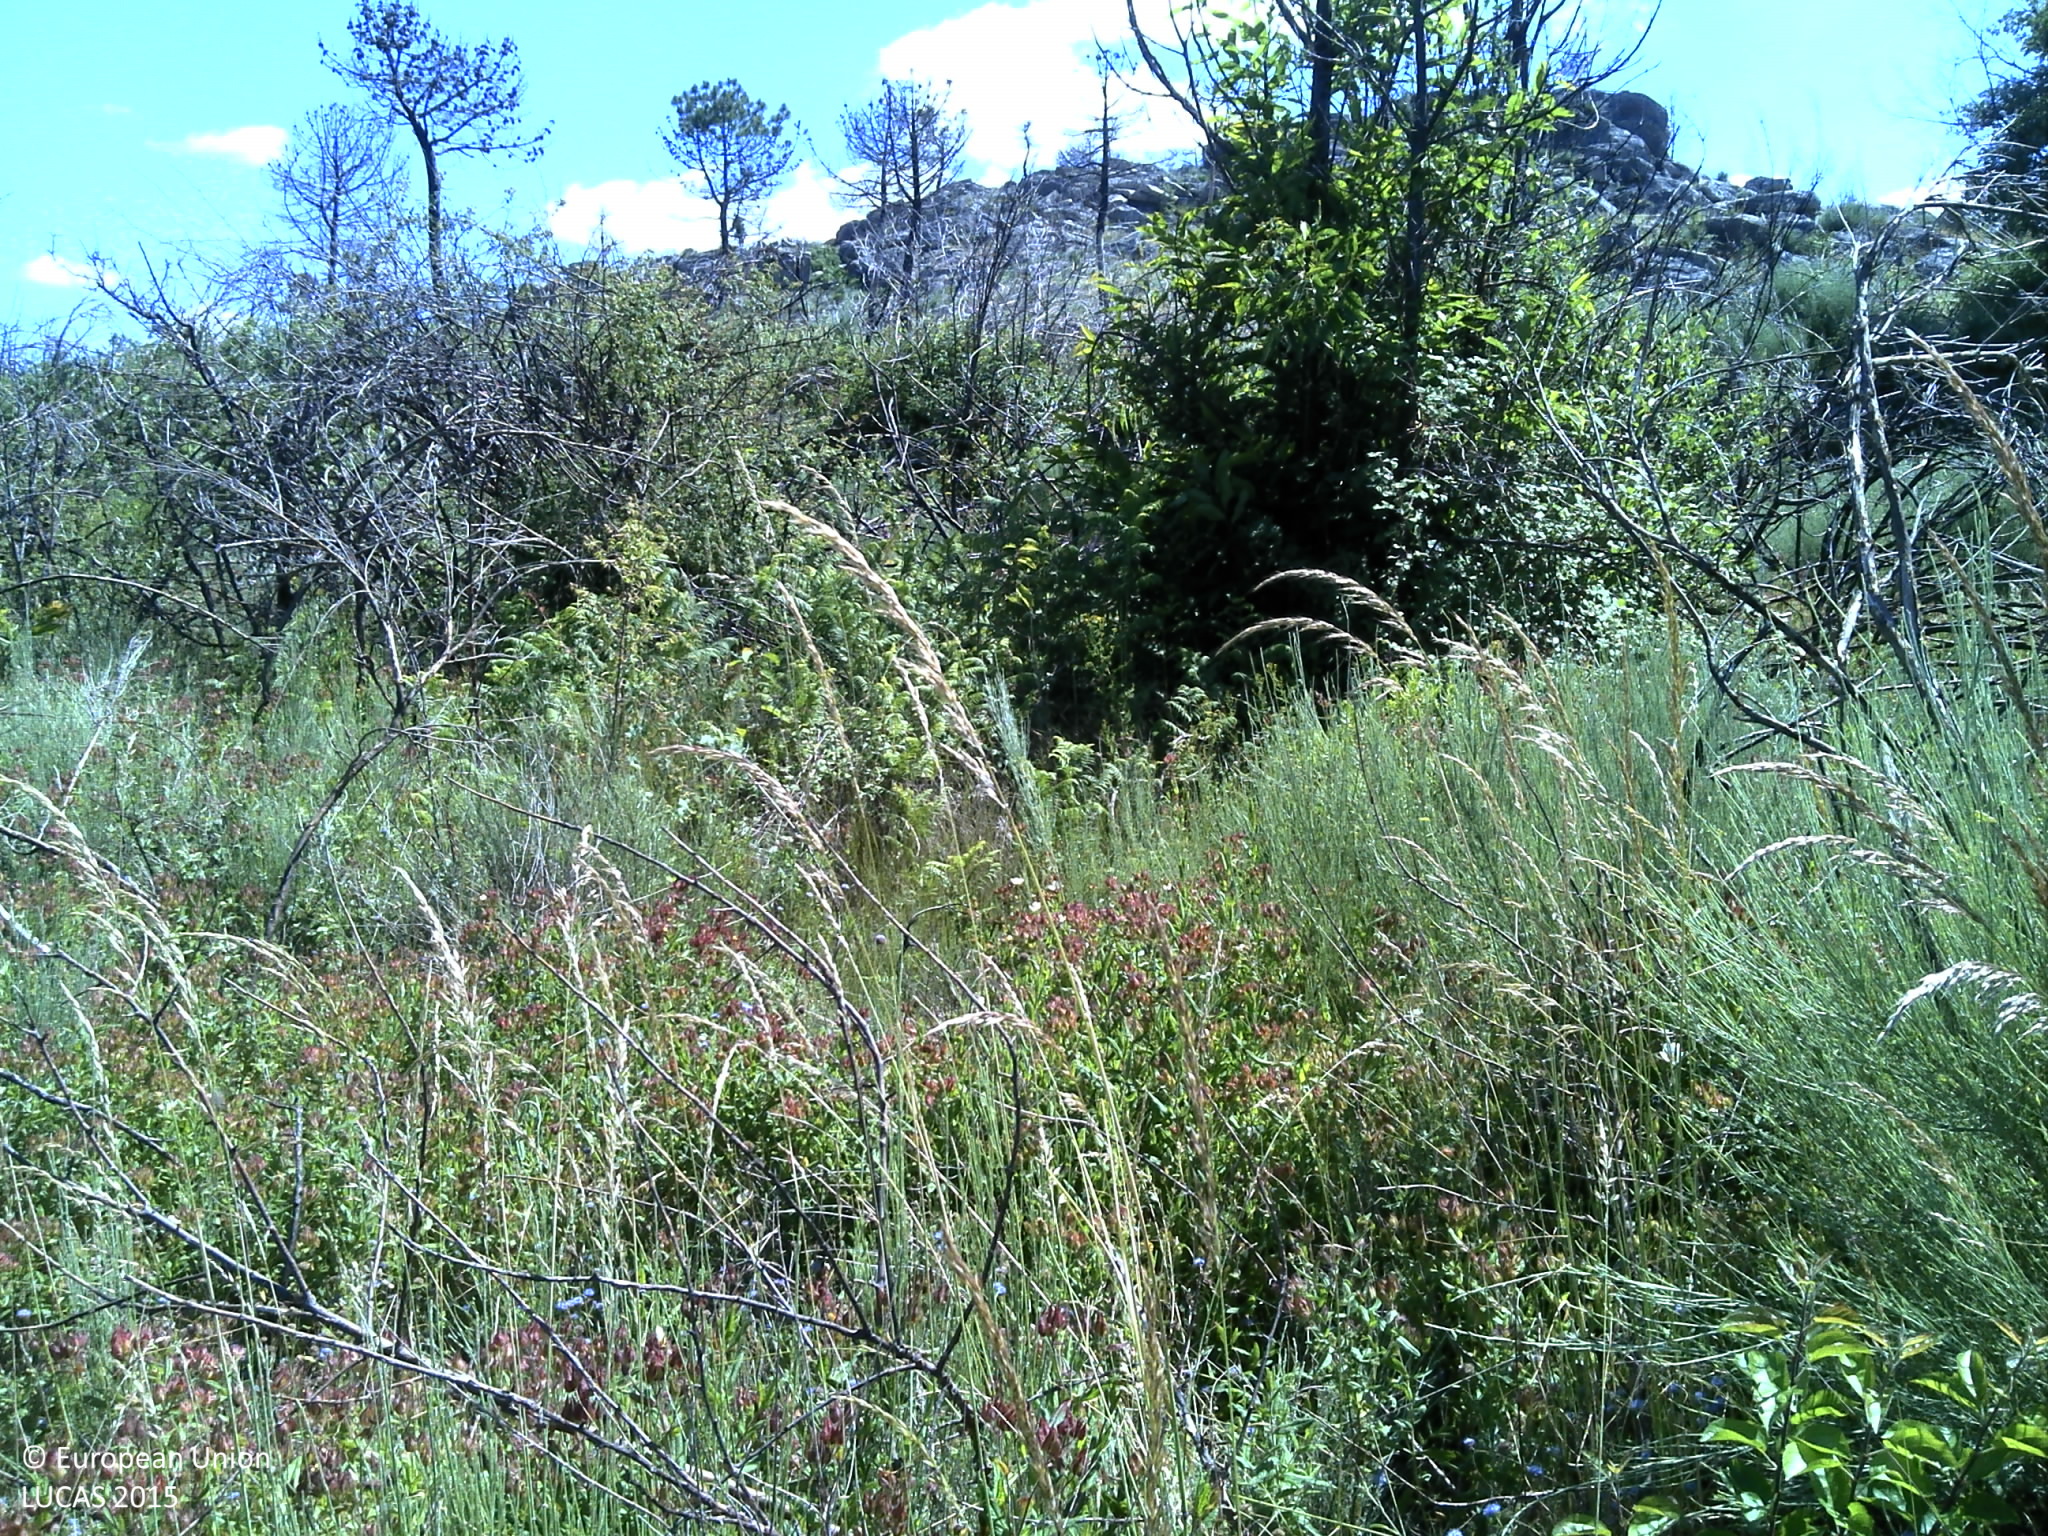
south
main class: Shrubland
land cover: Shrubland with sparse tree cover
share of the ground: 25 - 50 %
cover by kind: shrubs 40 %, unconsolidated bare surface 25 %, herbaceous plants 20 %, consolidated bare surface 10 %, broadleaved forest trees 5 %
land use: Forestry
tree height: < 5 m
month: June
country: PT
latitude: 41.0301
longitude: -7.5699
